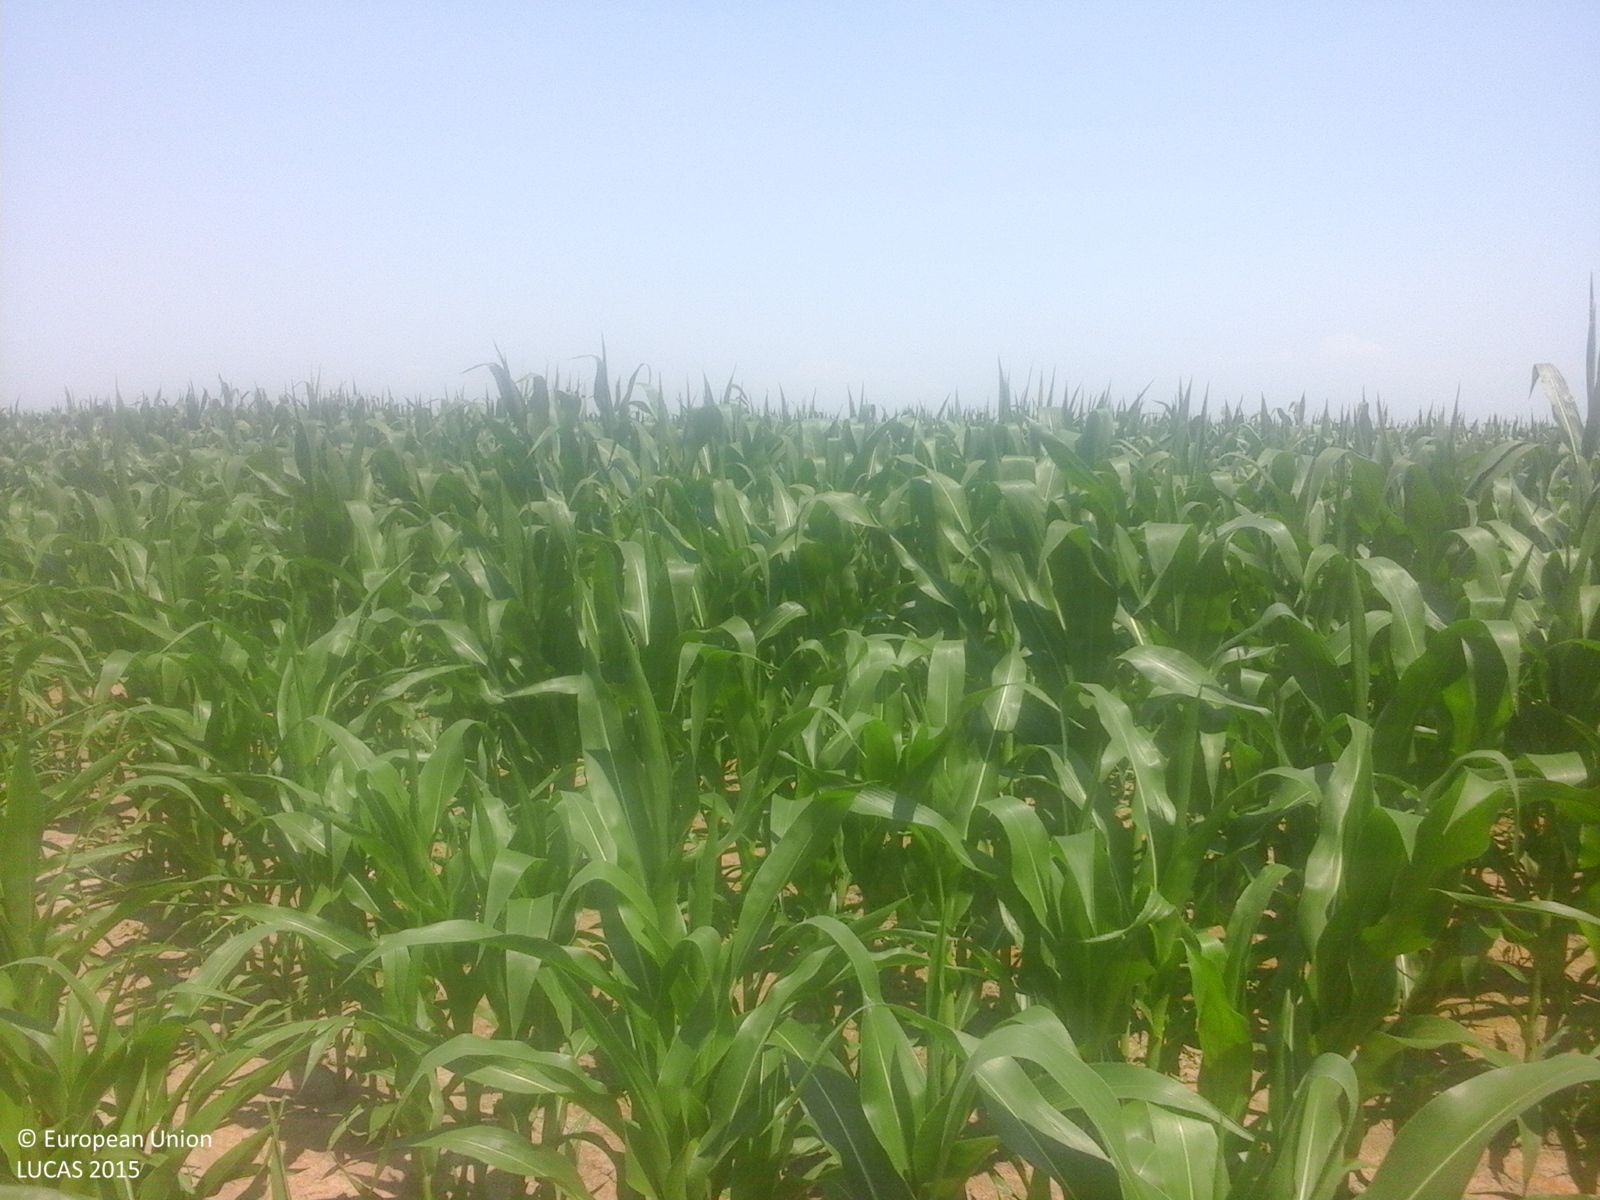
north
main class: Cropland
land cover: Maize
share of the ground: > 75 %
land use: Agriculture (excluding fallow land and kitchen gardens)
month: July
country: RO
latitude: 44.7194
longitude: 24.9923
